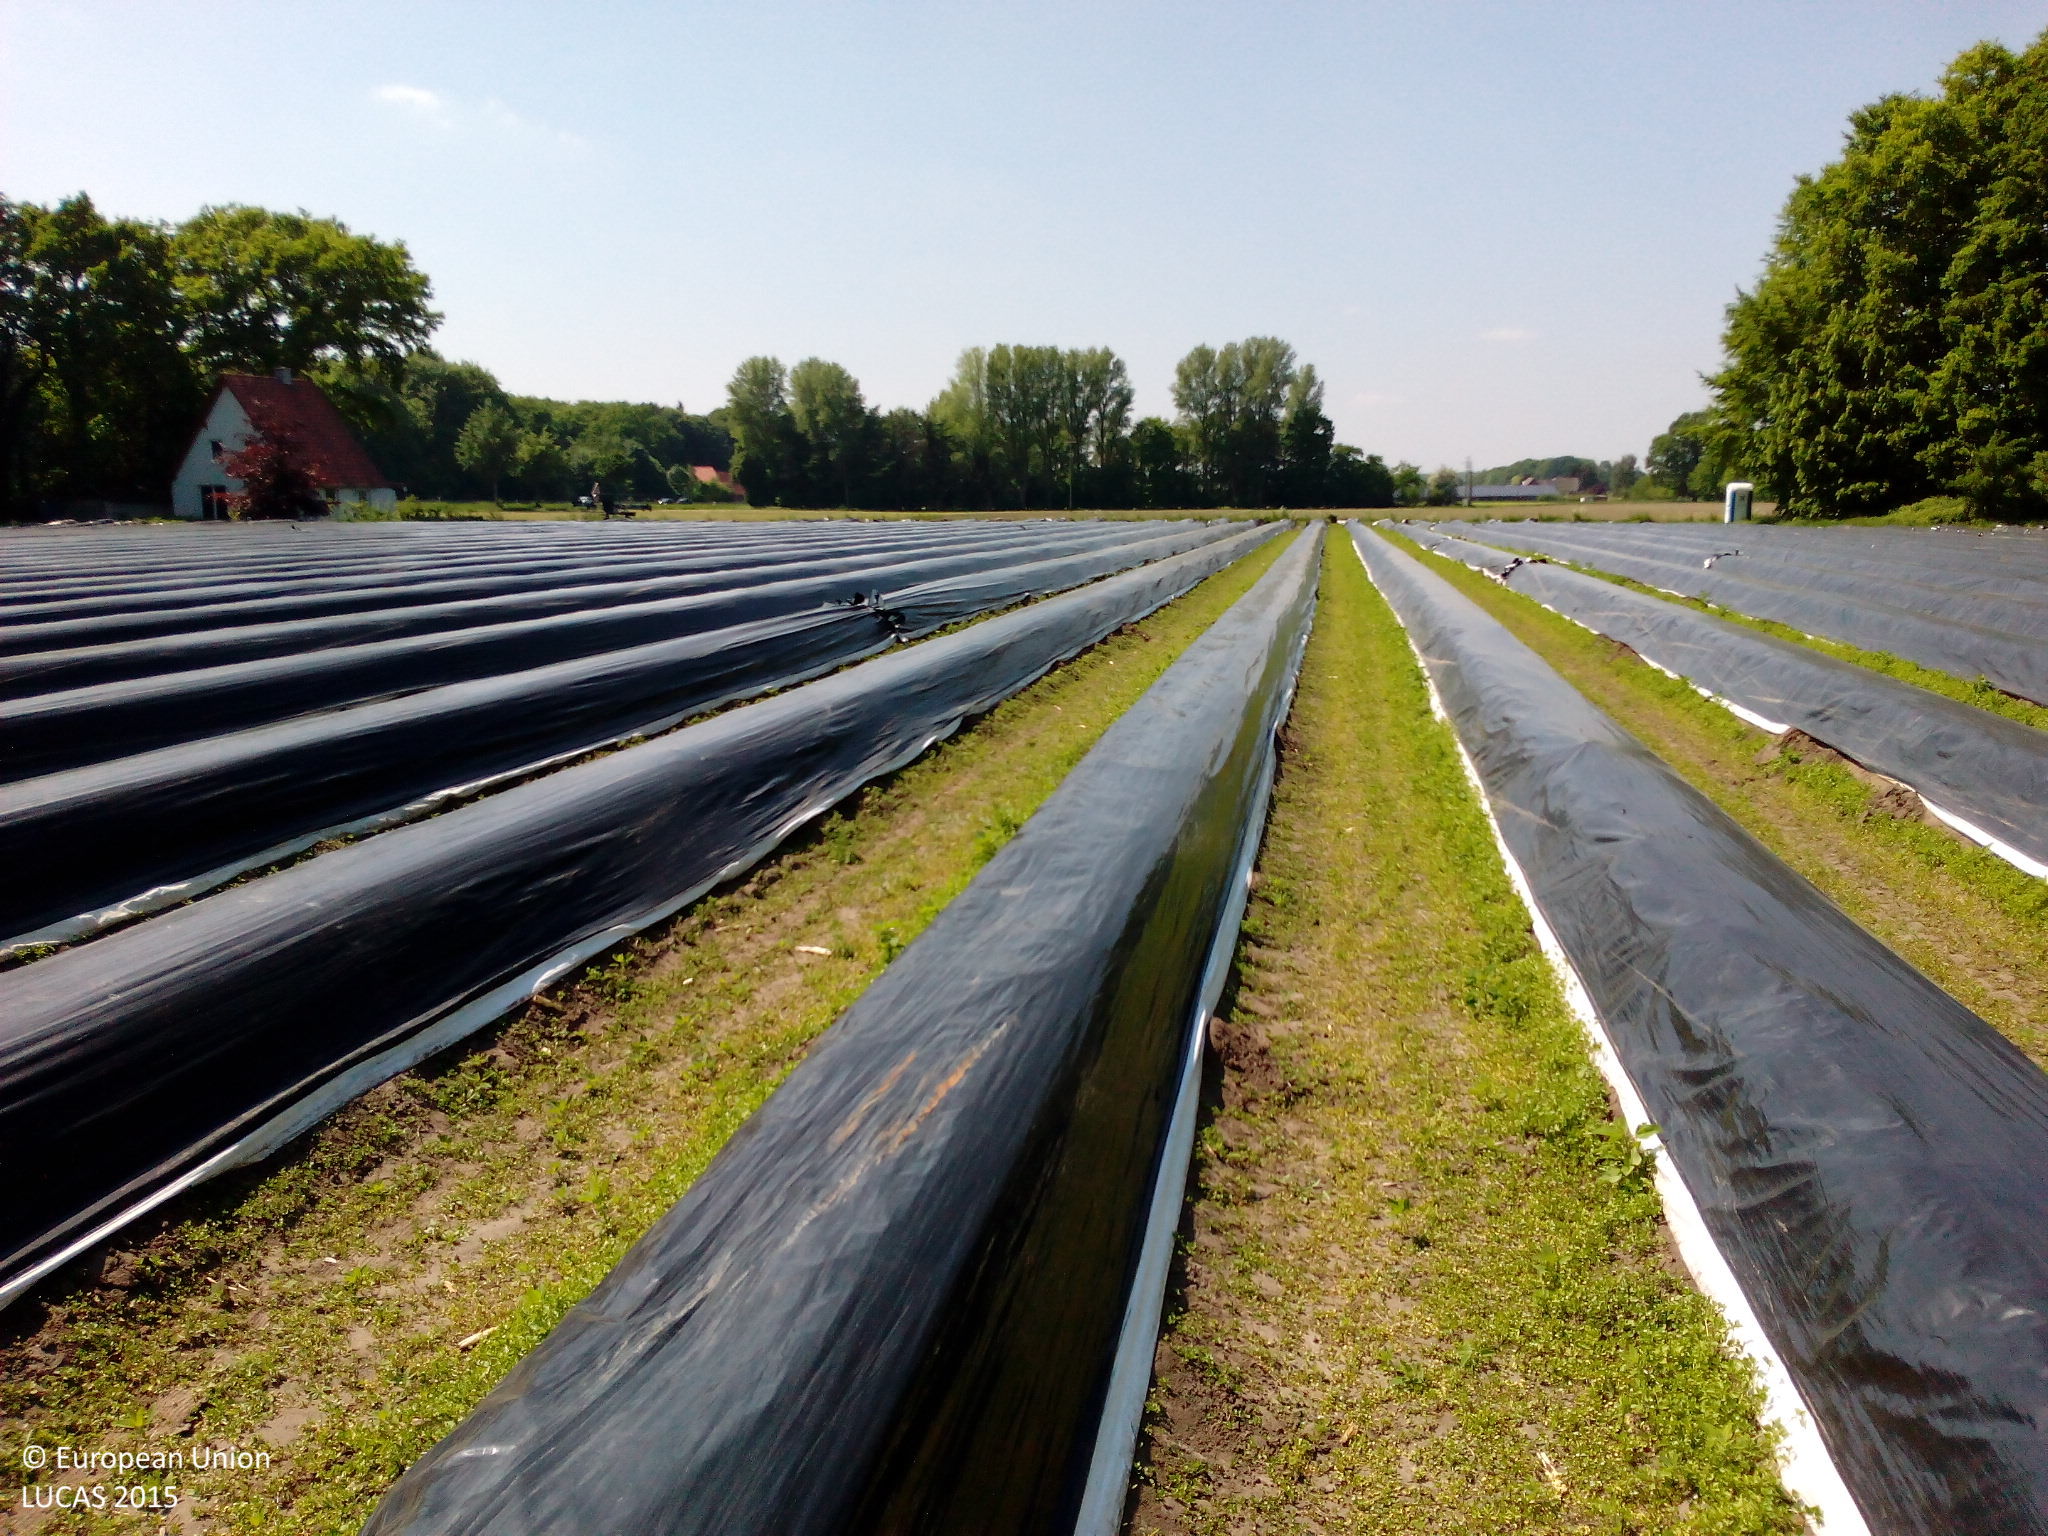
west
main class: Cropland
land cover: Other fresh vegetables
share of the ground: < 10 %
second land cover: Spontaneously vegetated surfaces
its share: 50 - 75 %
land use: Agriculture (excluding fallow land and kitchen gardens)
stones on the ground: < 10 %
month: May
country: DE
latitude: 51.9477
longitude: 8.0363
